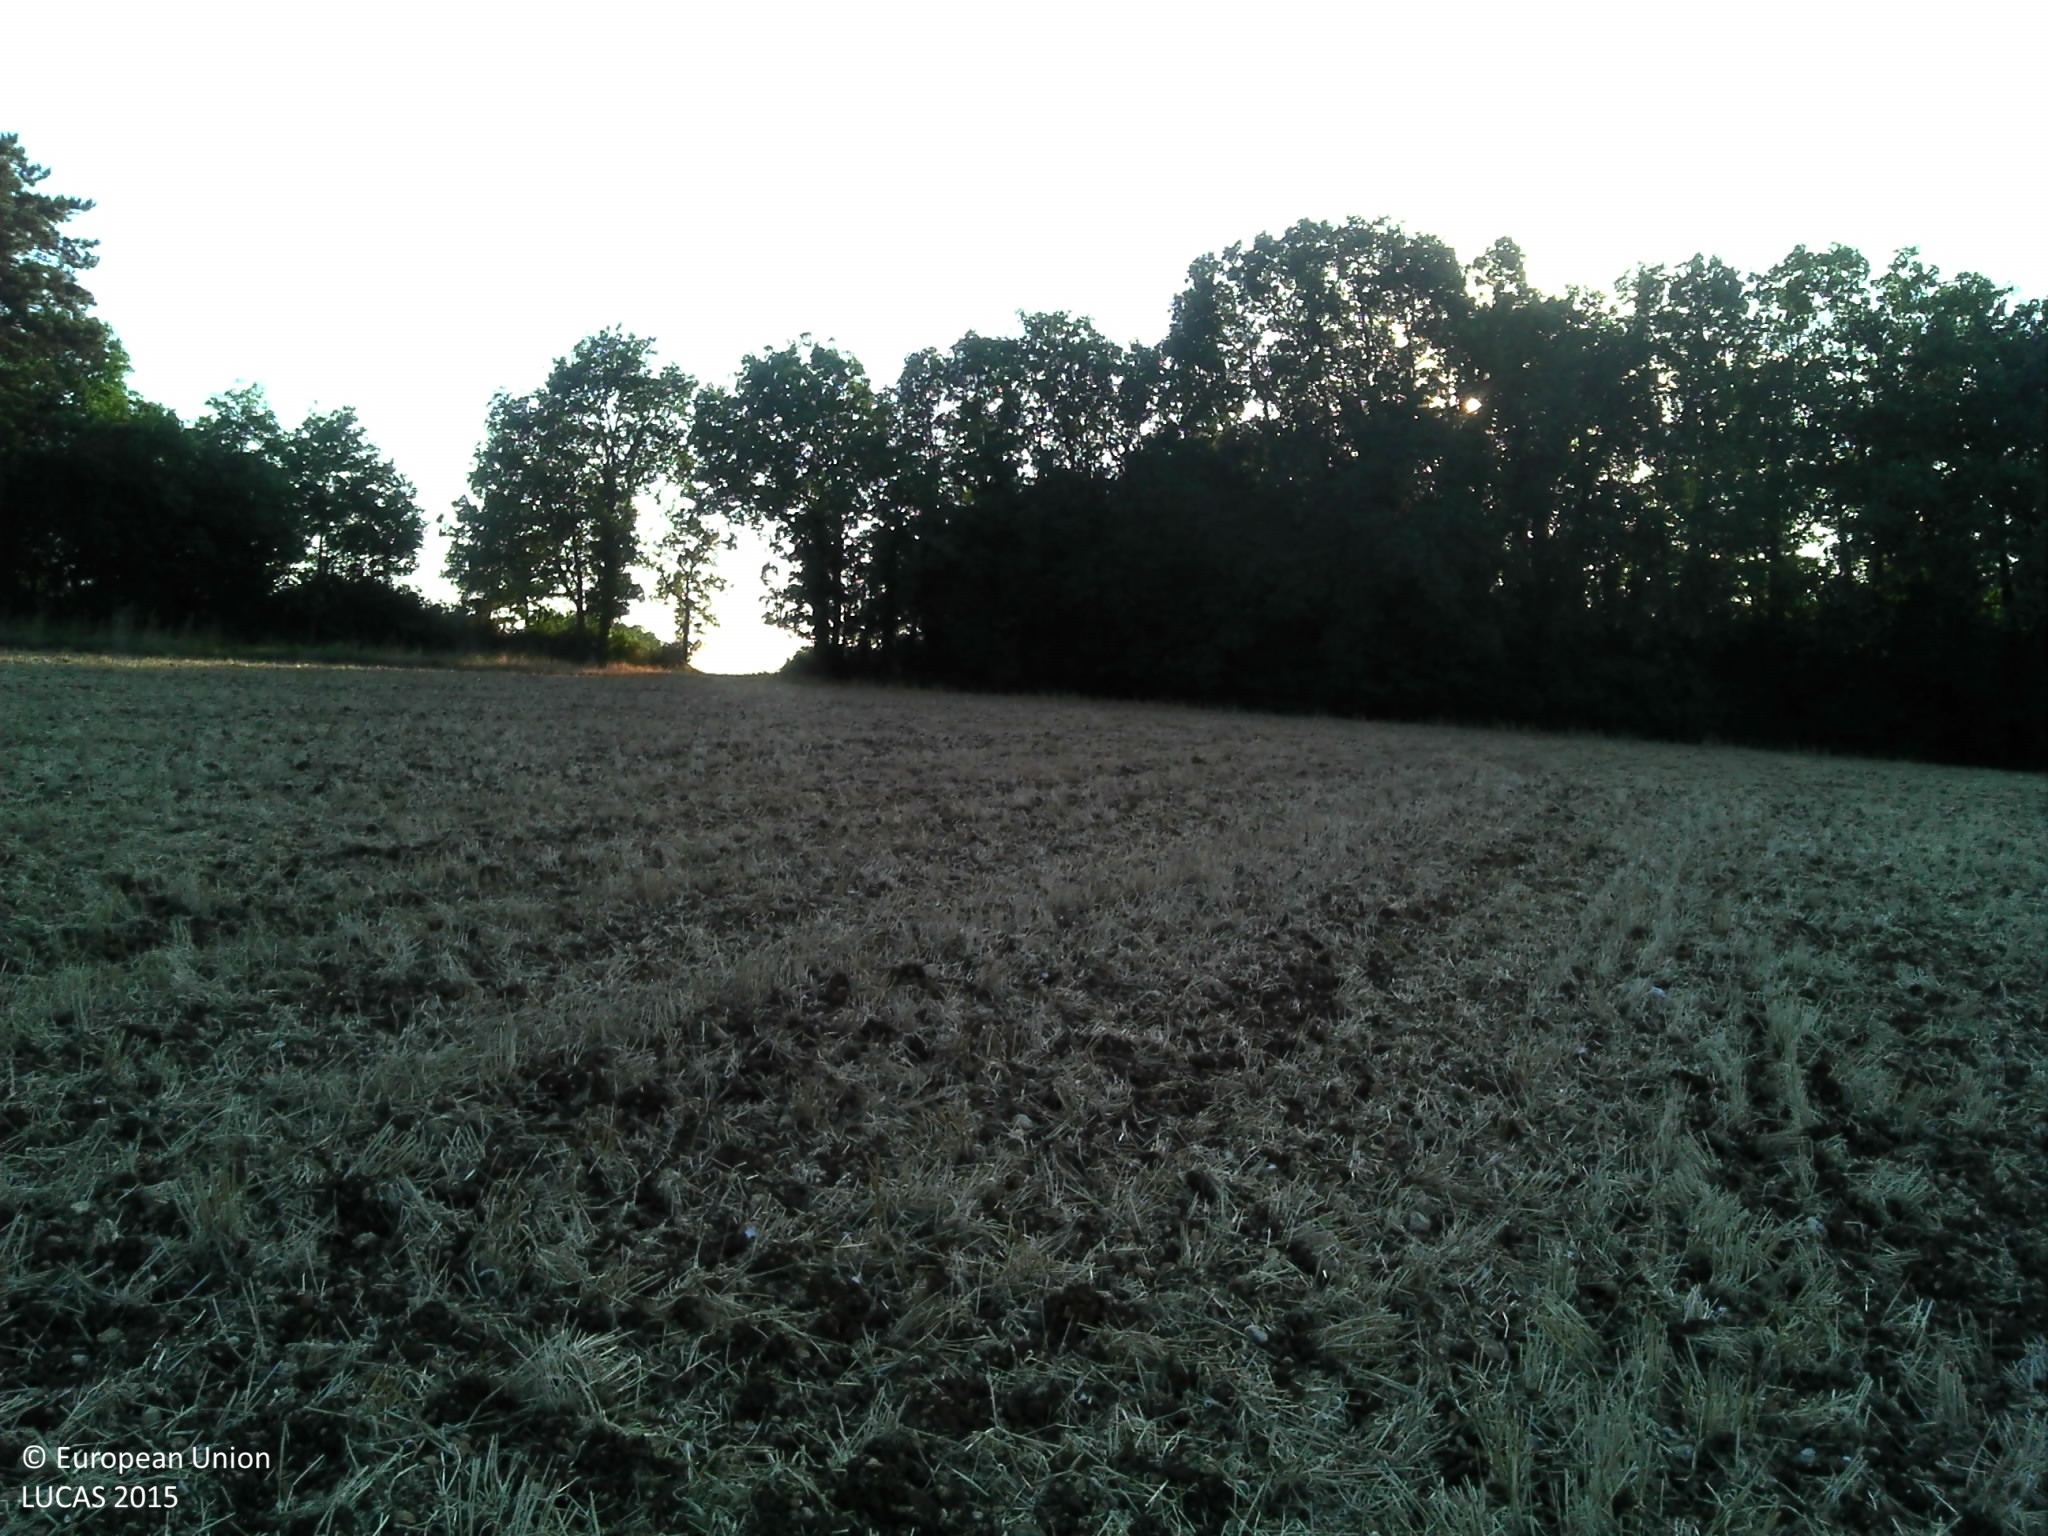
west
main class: Cropland
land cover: Triticale
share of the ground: 10 - 25 %
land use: Agriculture (excluding fallow land and kitchen gardens)
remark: Harvested field
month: August
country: FR
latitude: 45.4277
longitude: 0.3878
